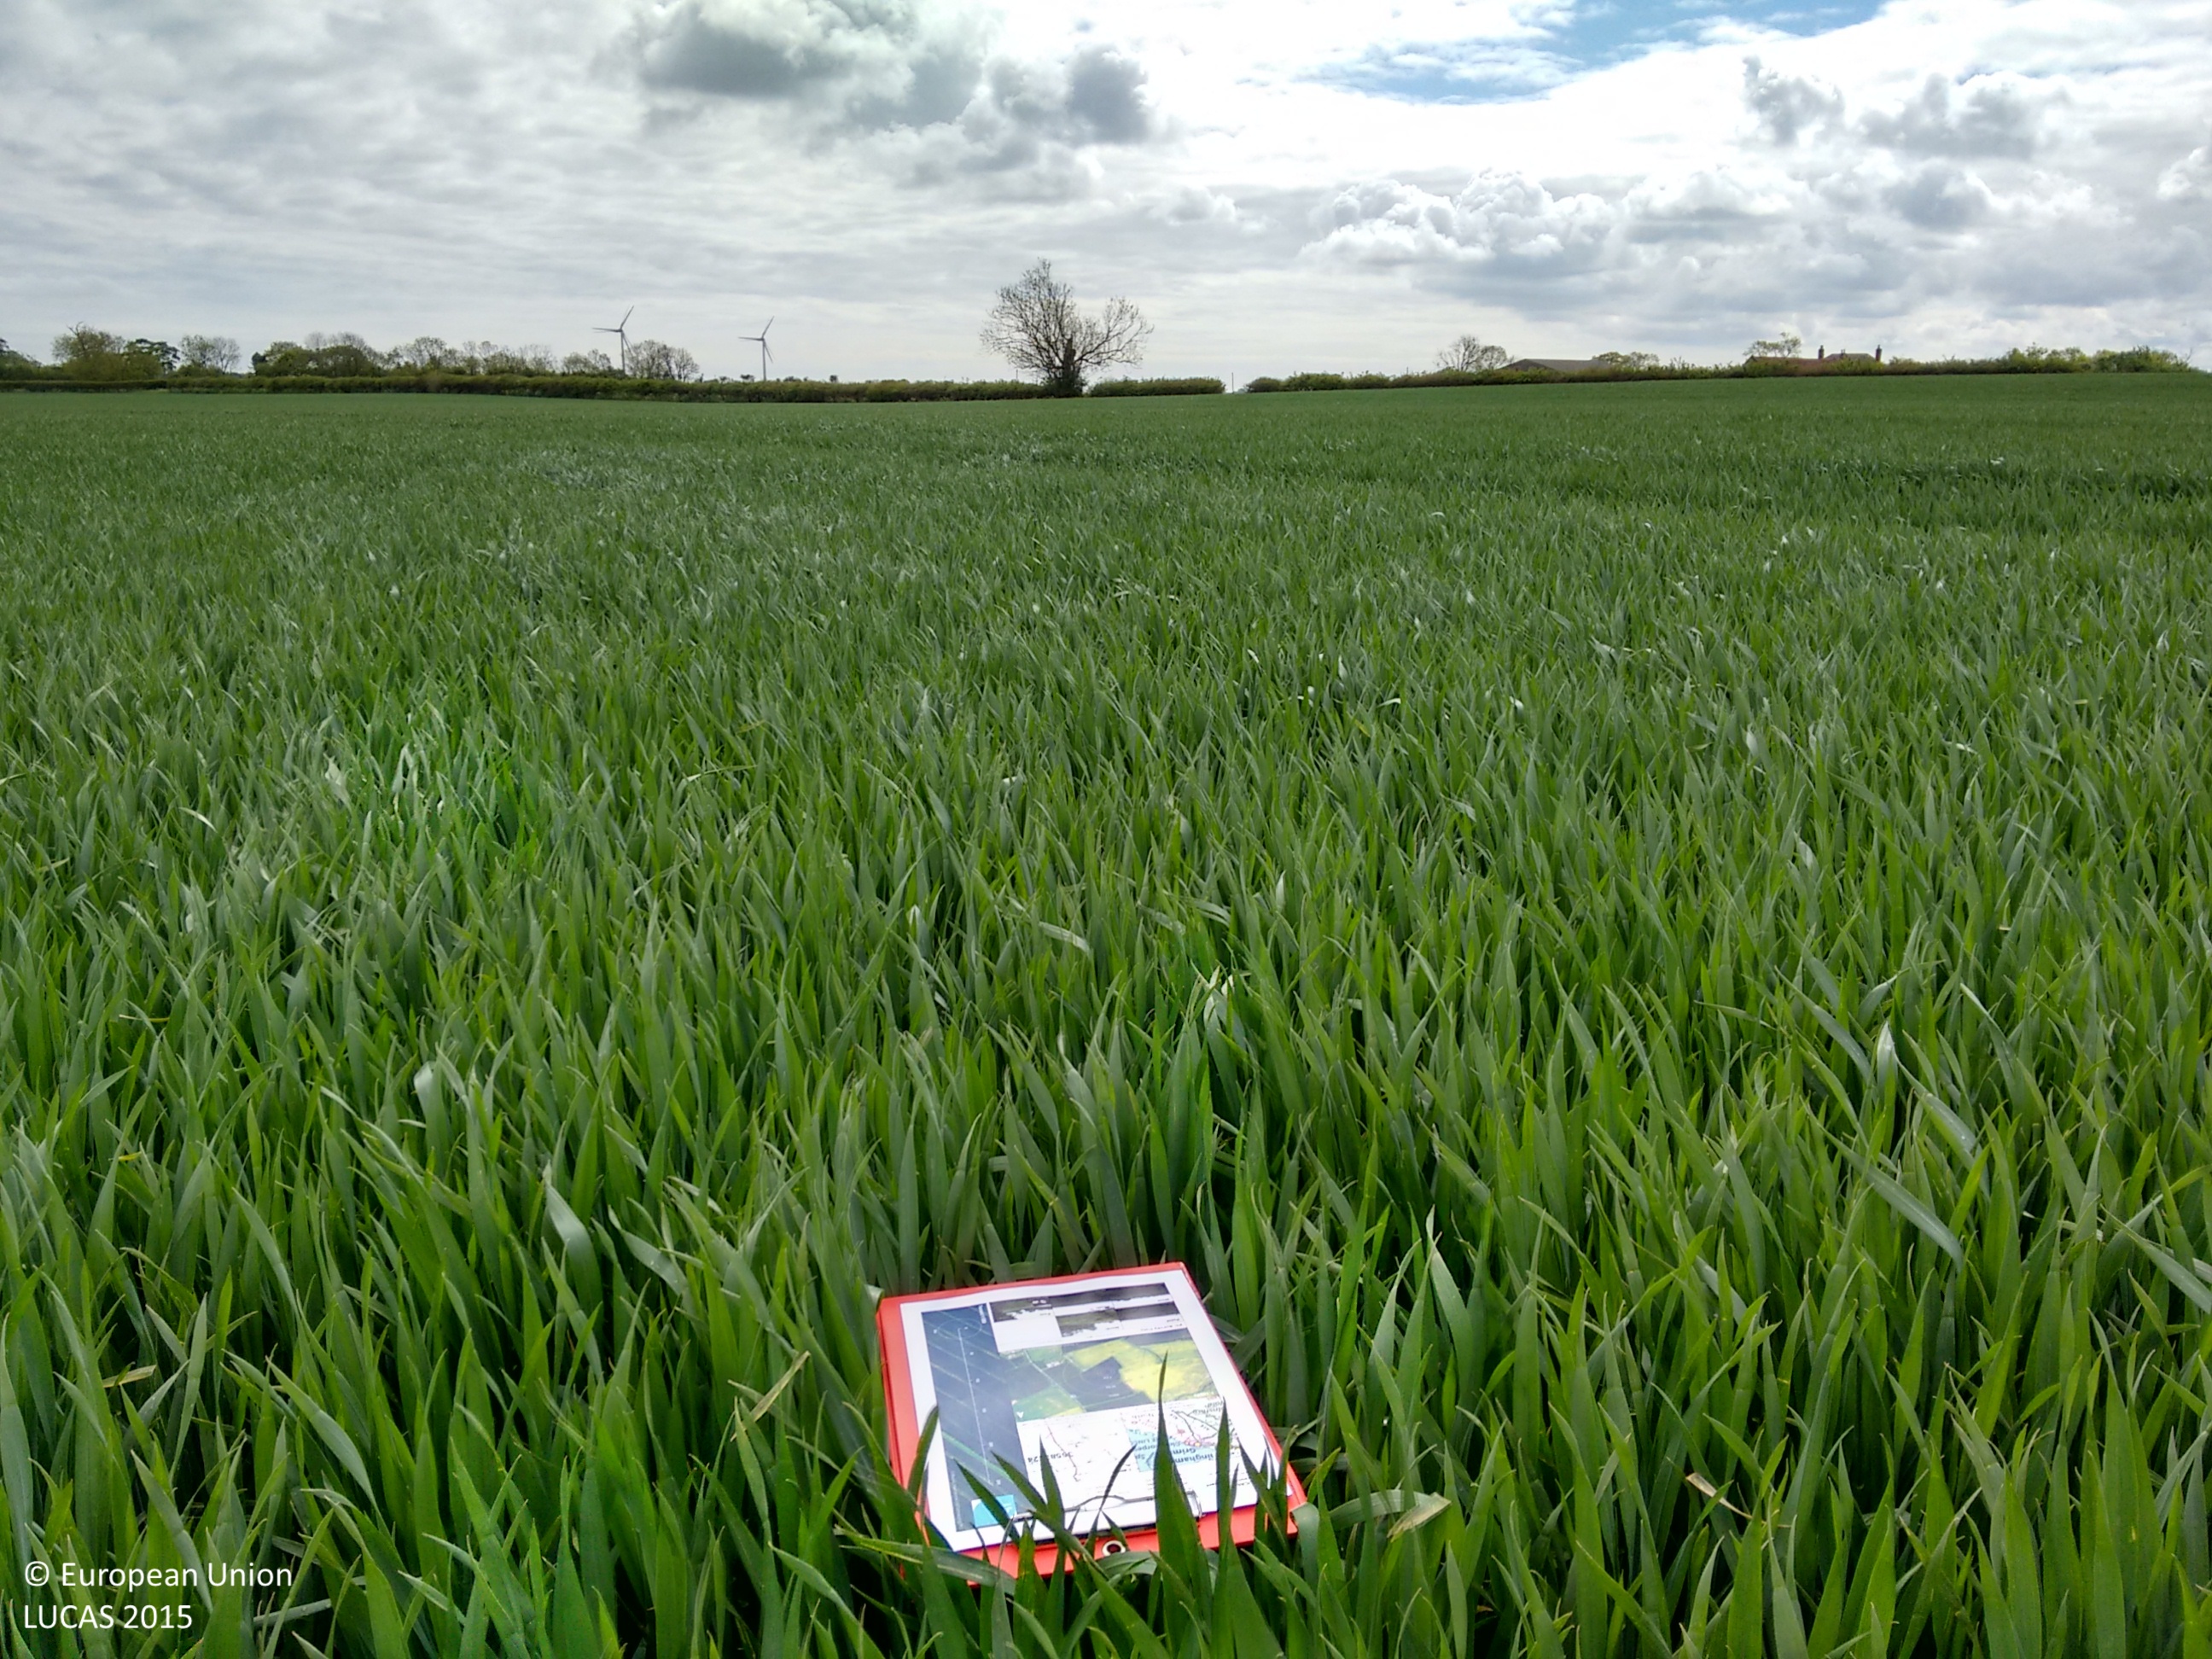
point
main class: Cropland
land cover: Common wheat
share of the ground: > 75 %
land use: Agriculture (excluding fallow land and kitchen gardens)
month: May
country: GB
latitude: 53.5101
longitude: -0.0294
